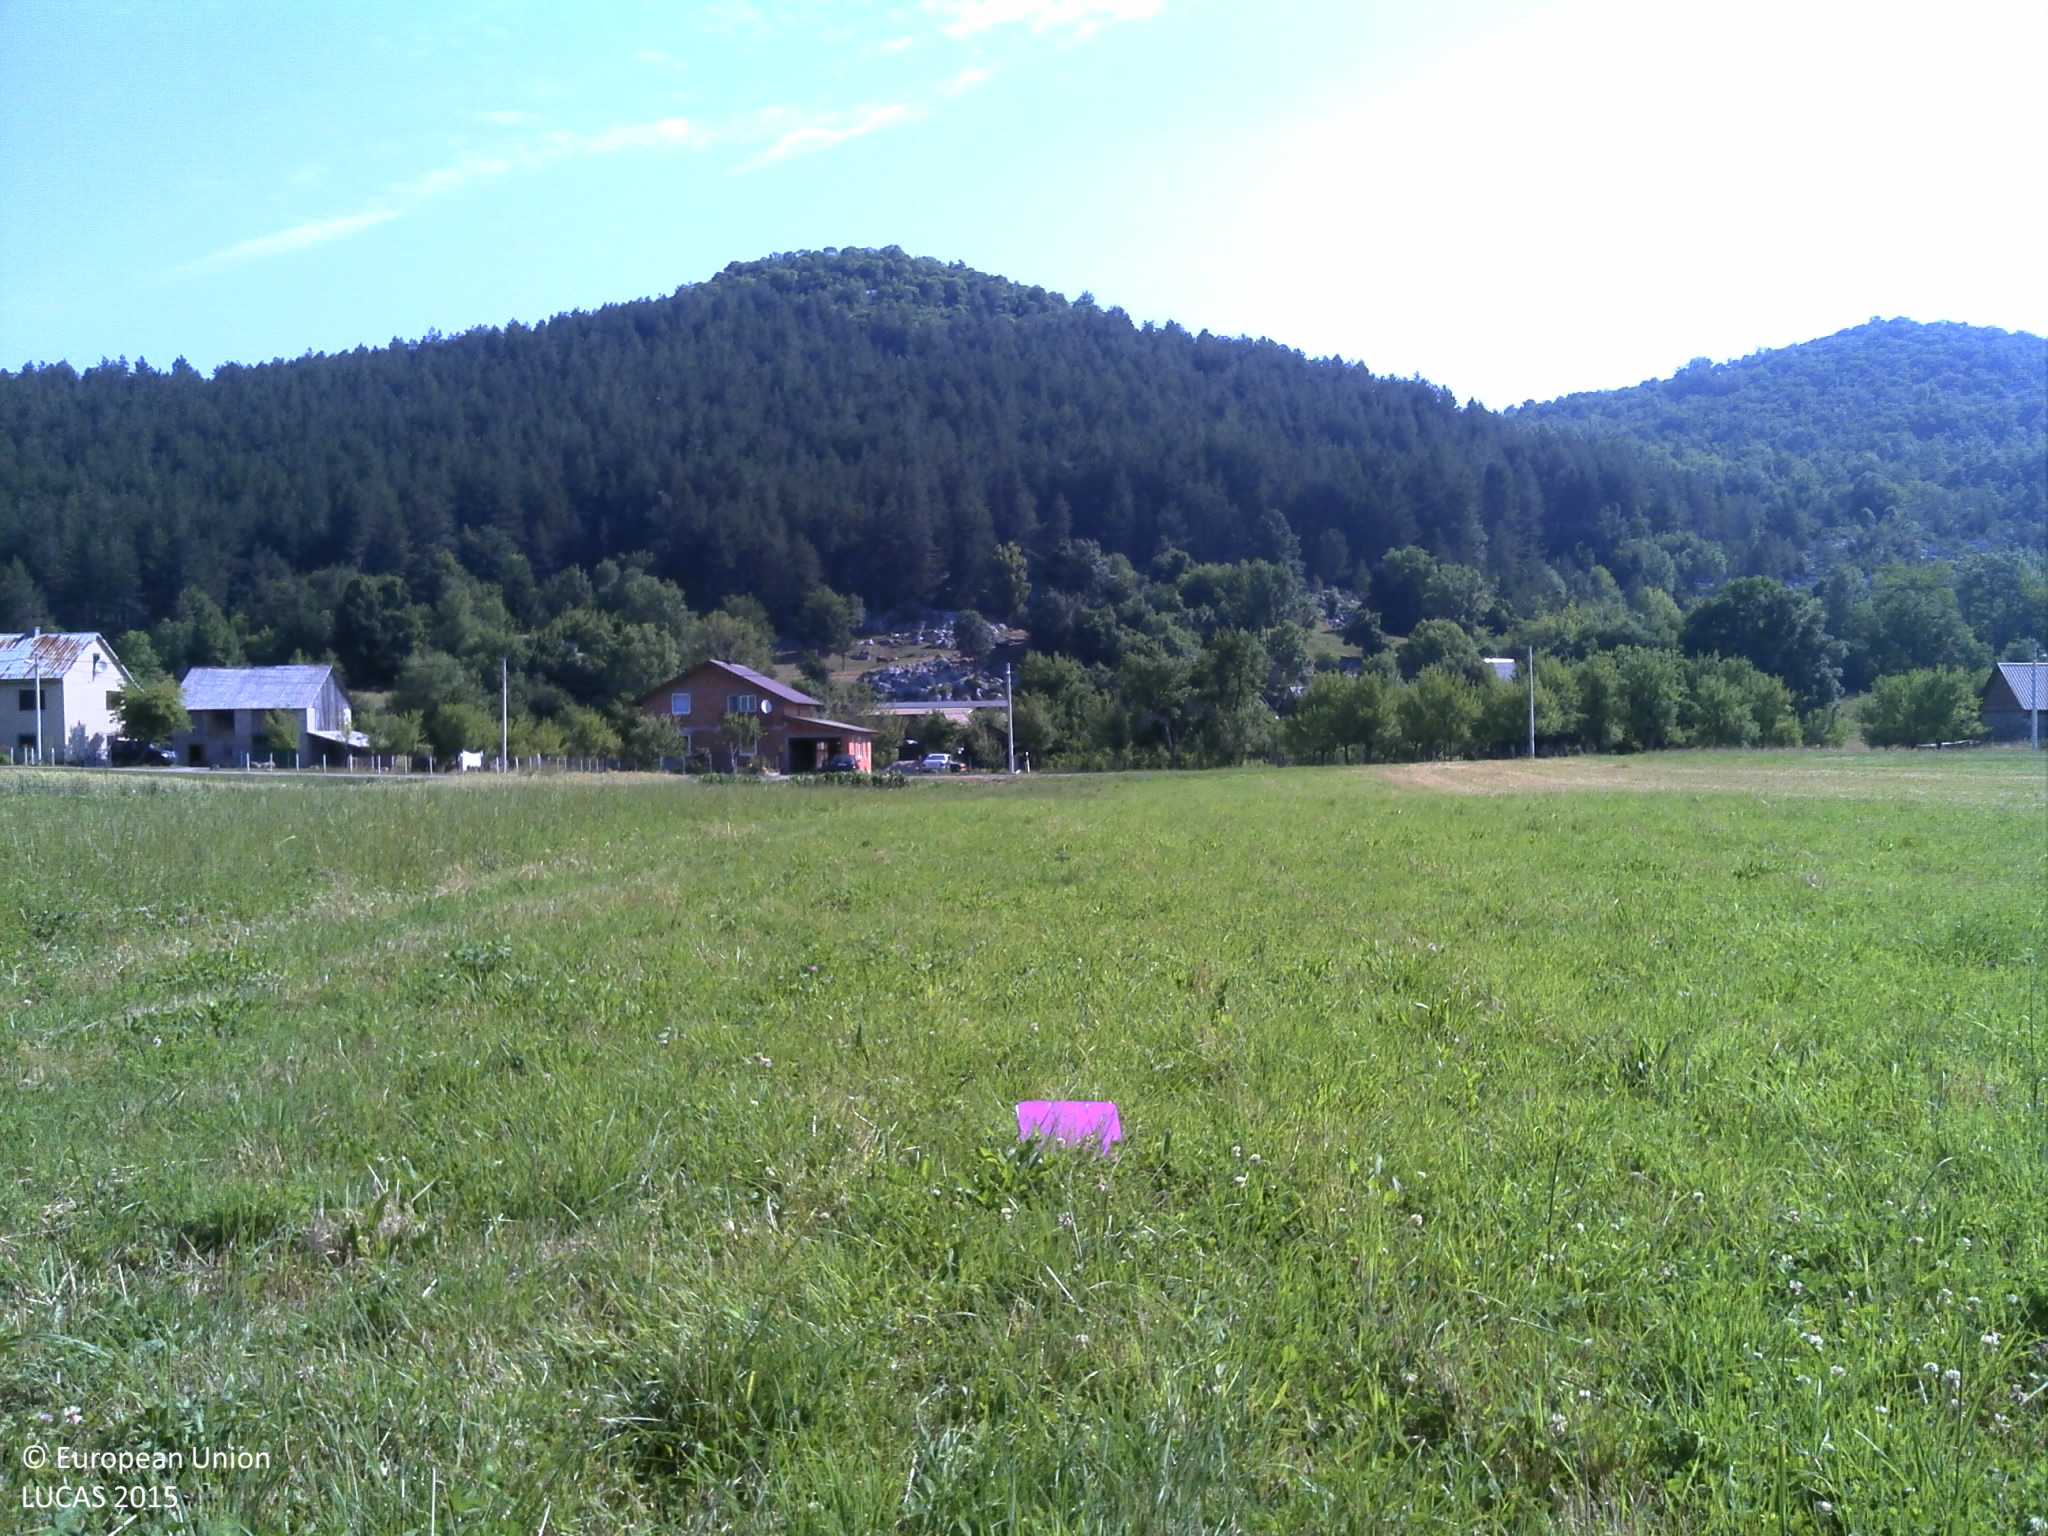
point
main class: Grassland
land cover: Grassland without tree/shrub cover
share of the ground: > 75 %
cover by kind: herbaceous plants 100 %
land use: Agriculture (excluding fallow land and kitchen gardens)
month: July
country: HR
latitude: 44.6538
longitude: 15.2015
